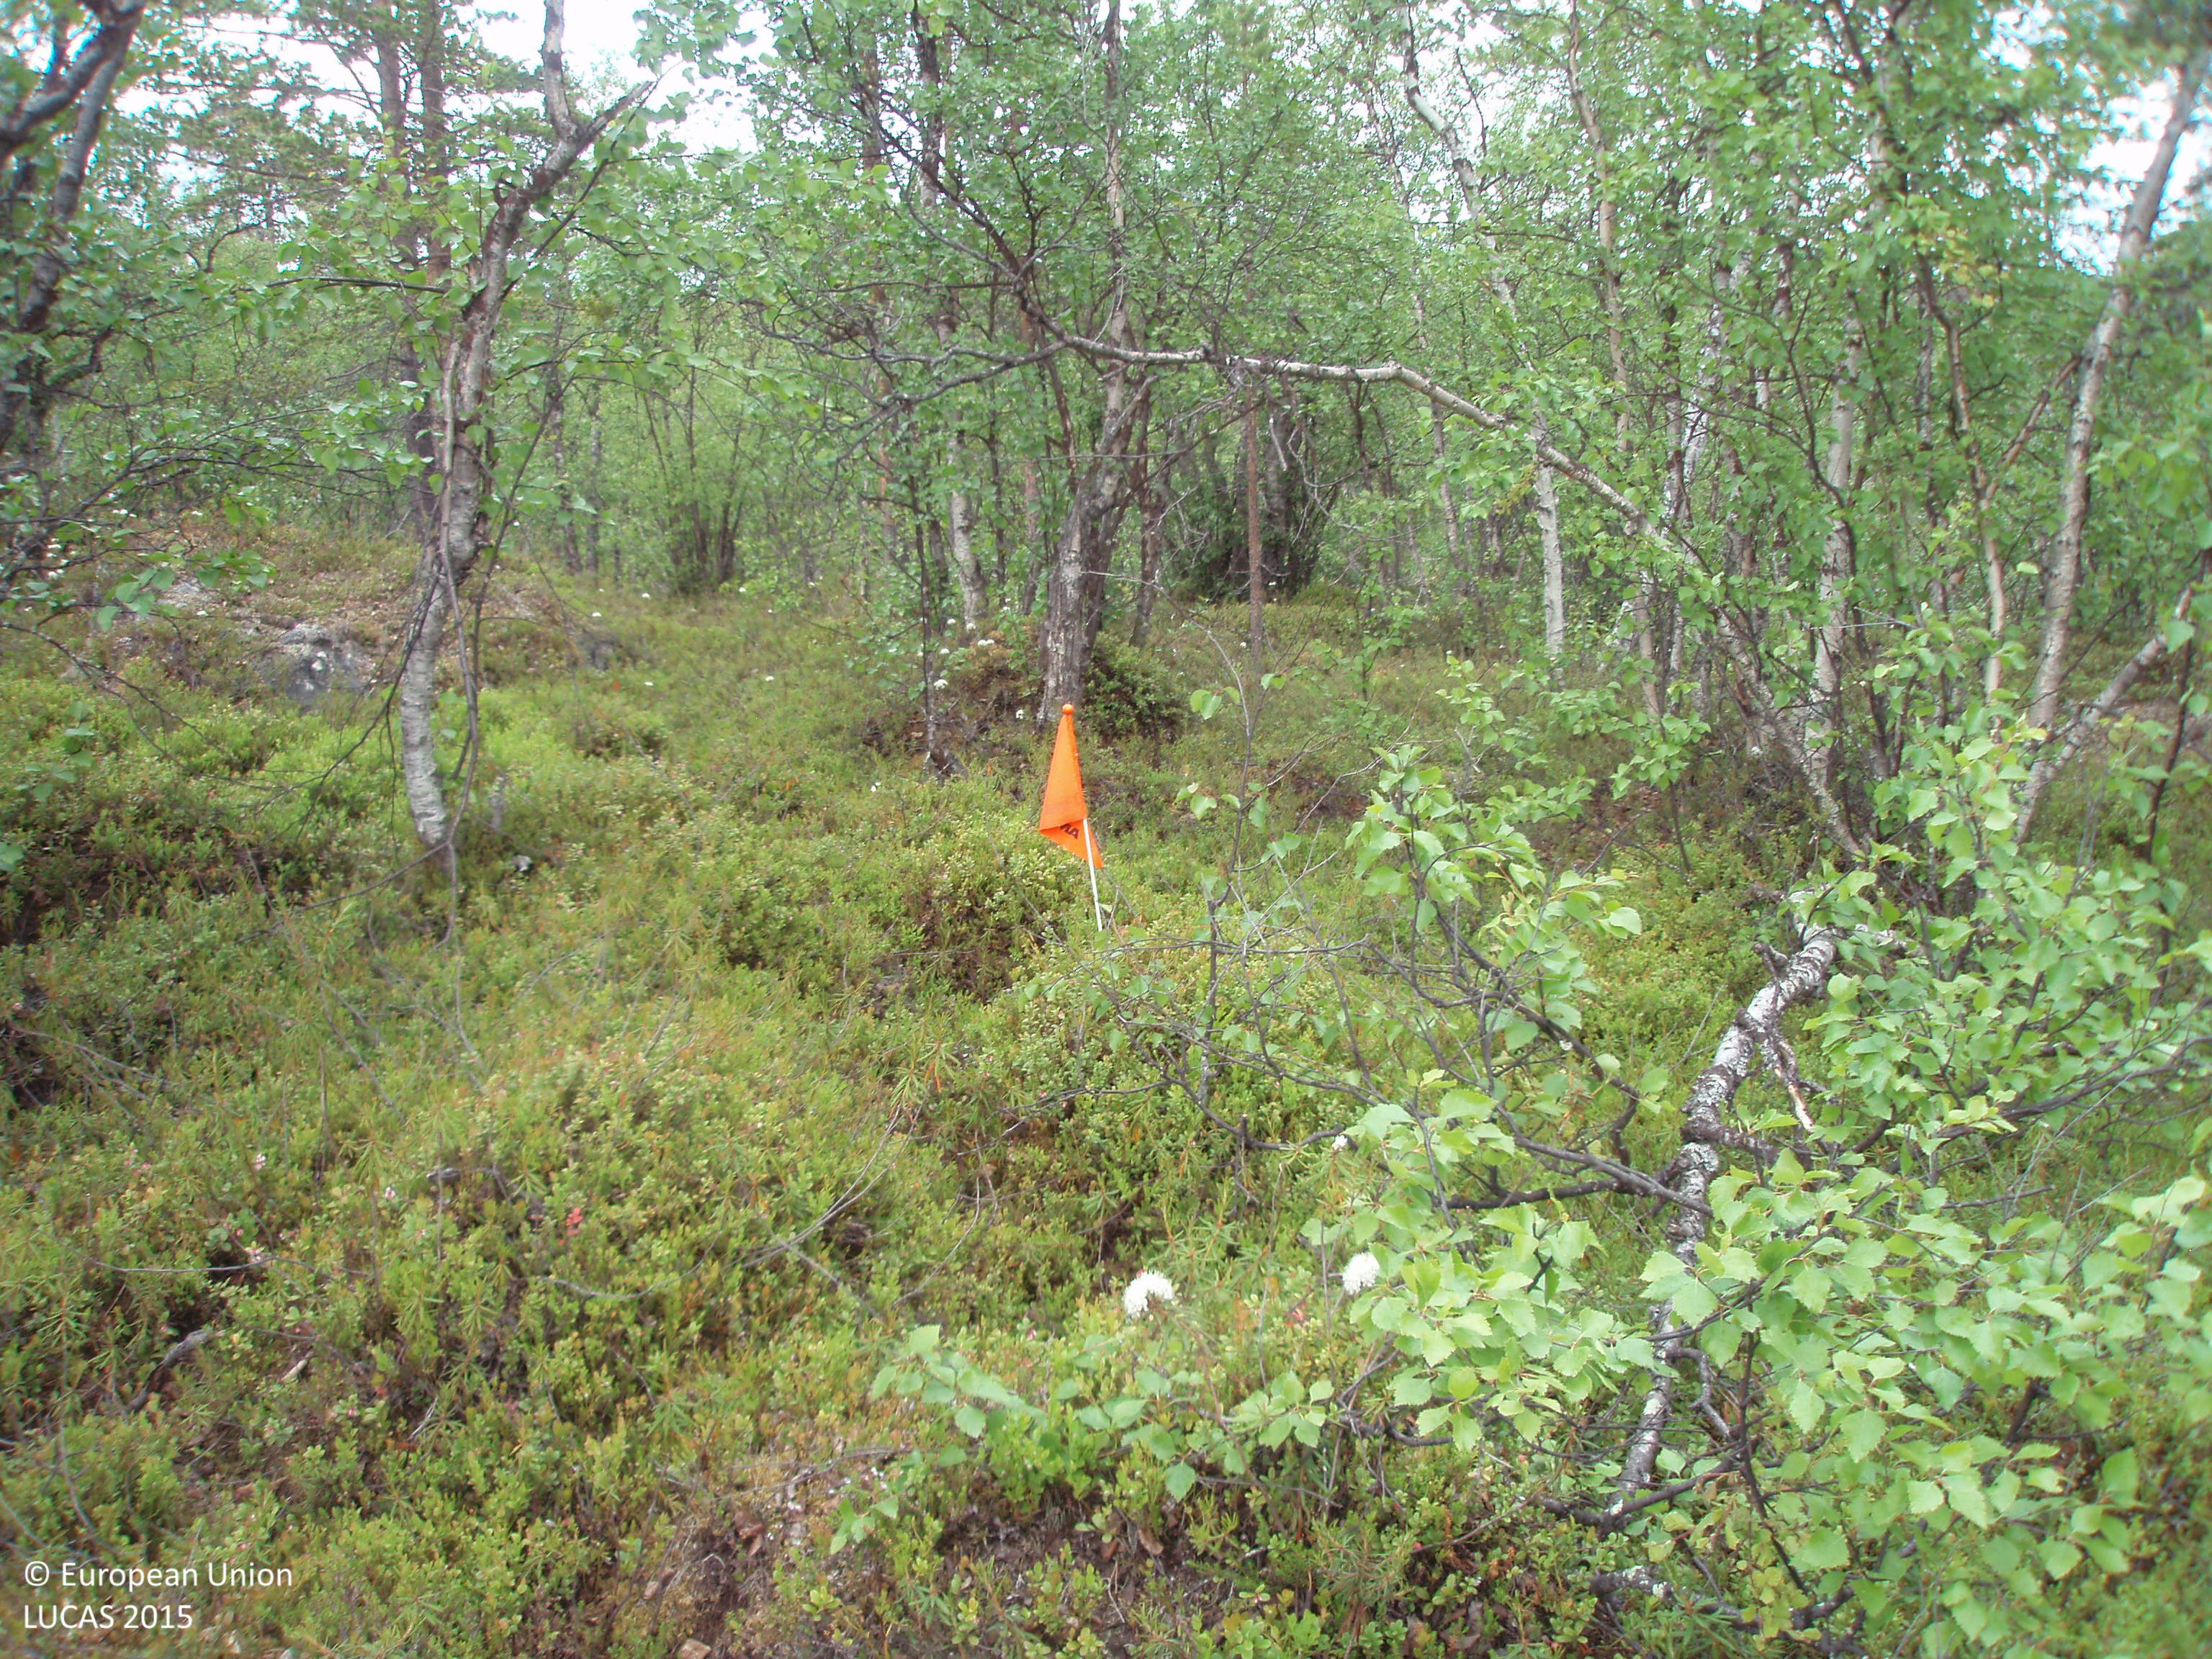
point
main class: Woodland
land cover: Pine dominated mixed woodland
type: boreal forest
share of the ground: > 75 %
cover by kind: broadleaved forest trees 50 %, coniferous forest trees 25 %, shrubs 25 %
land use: Forestry
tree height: > 5 m
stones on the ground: 10 - 25 %
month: July
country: FI
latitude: 69.1573
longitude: 27.7796
